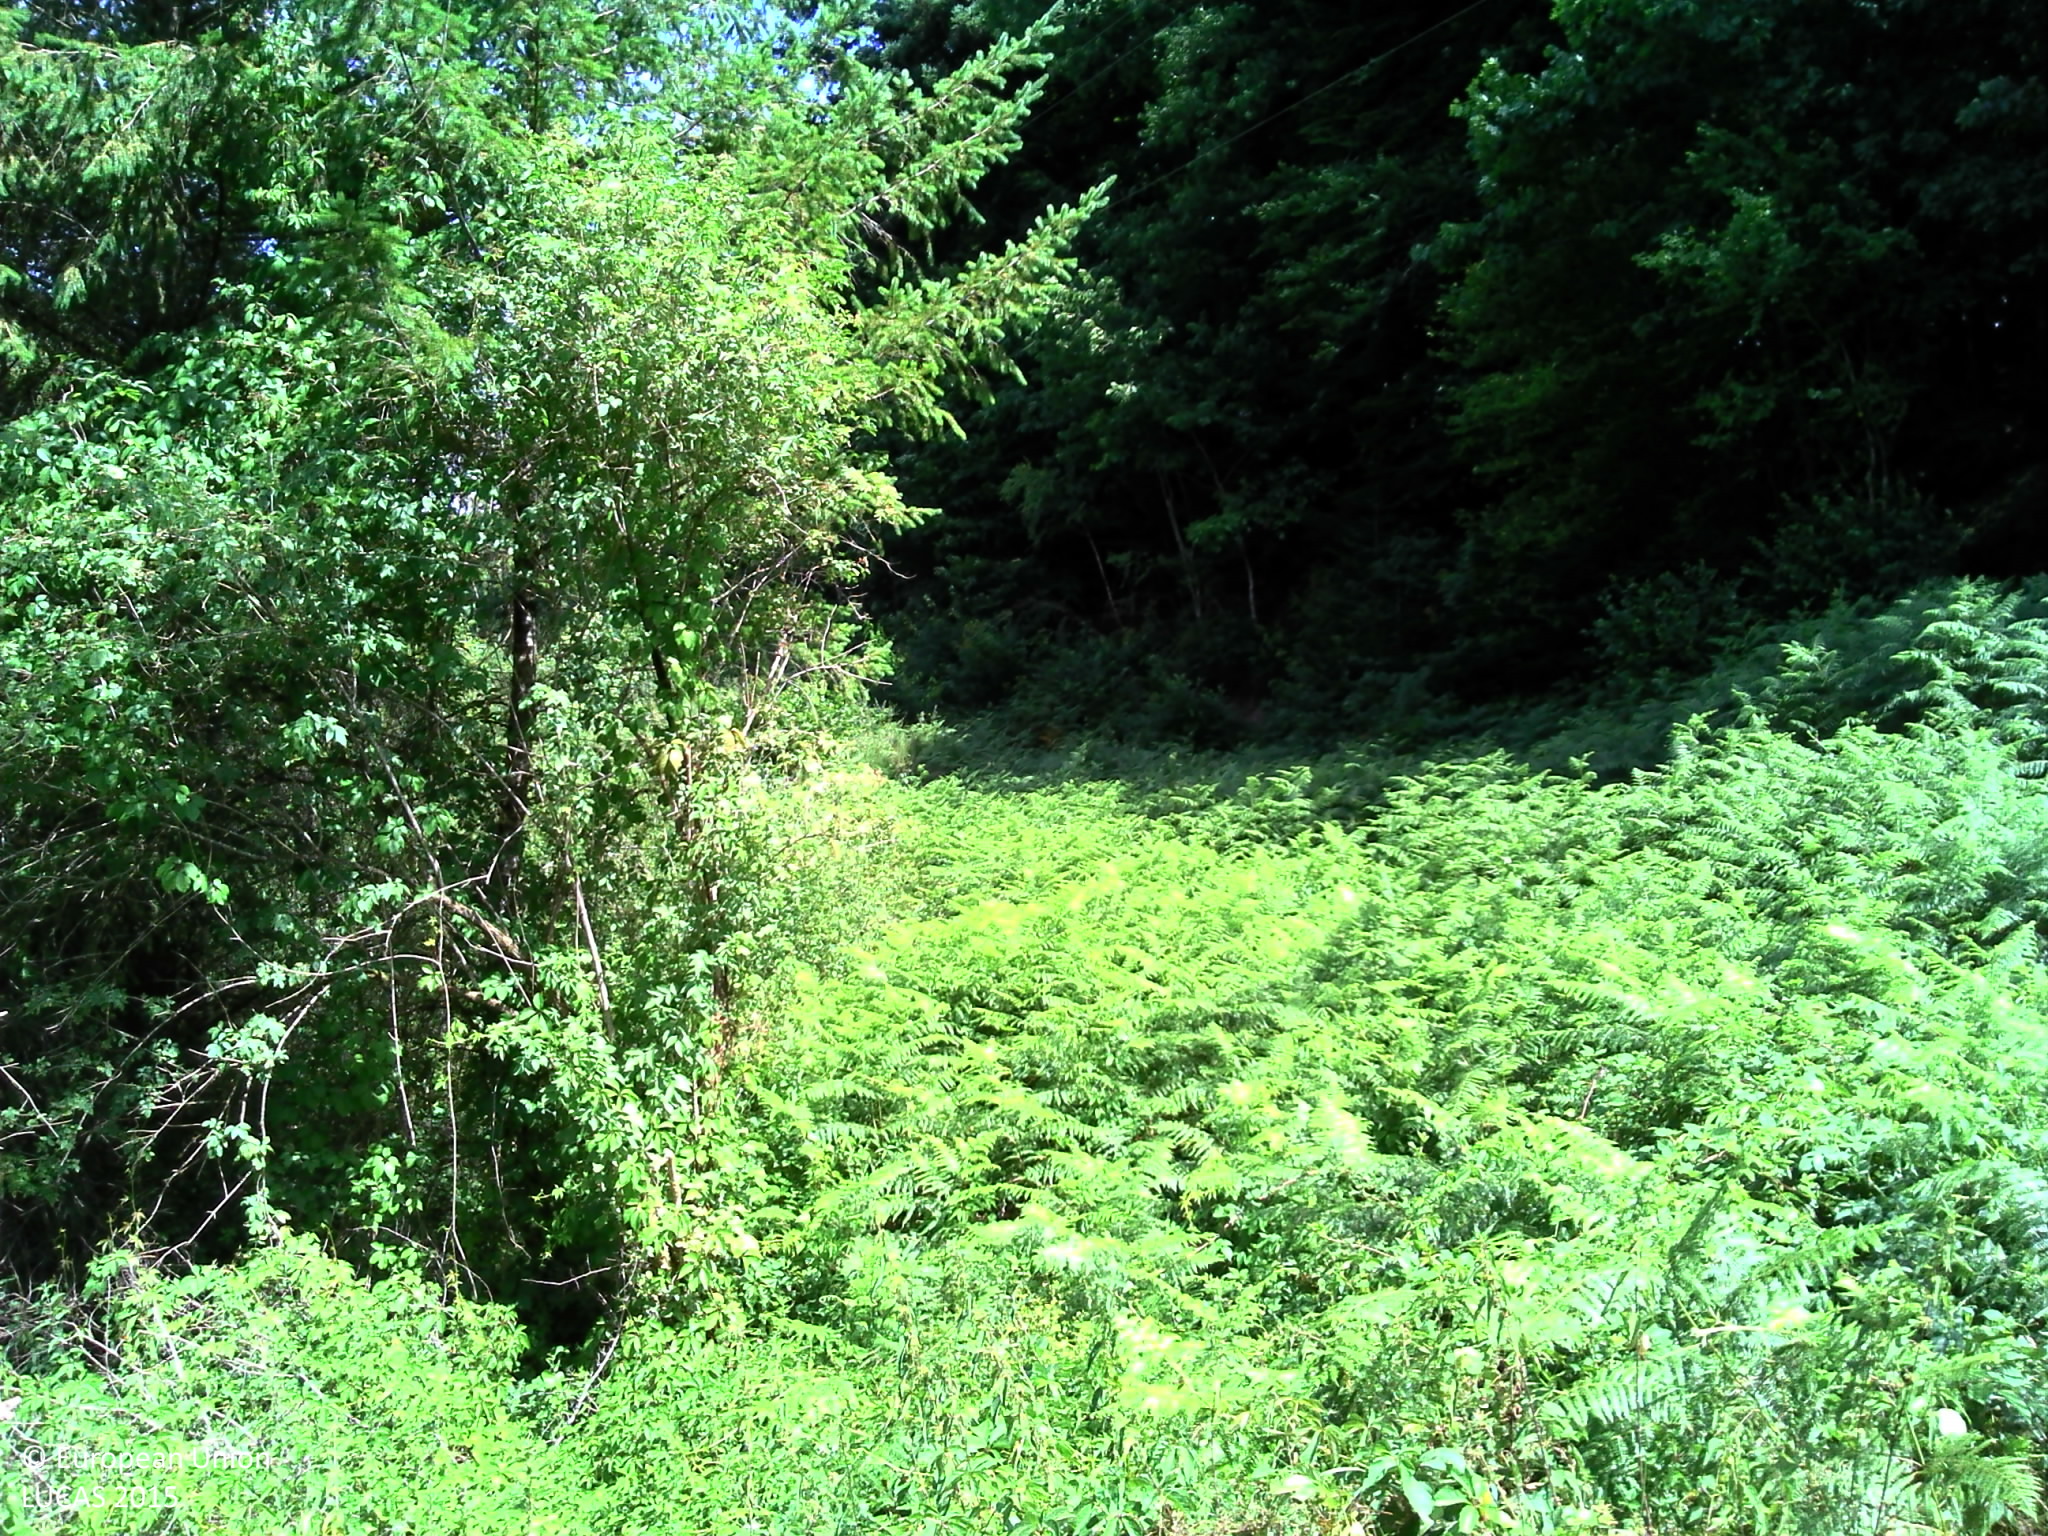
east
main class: Grassland
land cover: Spontaneously vegetated surfaces
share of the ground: > 75 %
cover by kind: herbaceous plants 95 %
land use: Semi-natural and natural areas not in use
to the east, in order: Paved roads, cycling and walking lanes; Grass margins; Fences; Spontaneously vegetated surfaces; Electric lines; Spontaneously vegetated surfaces; Spruce dominated mixed woodland; Broadleaved woodland; Electric lines; Spontaneously vegetated surfaces; Grassland without tree/shrub cover; Fences; Grassland without tree/shrub cover
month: July
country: FR
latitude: 45.7865
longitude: 1.6193
